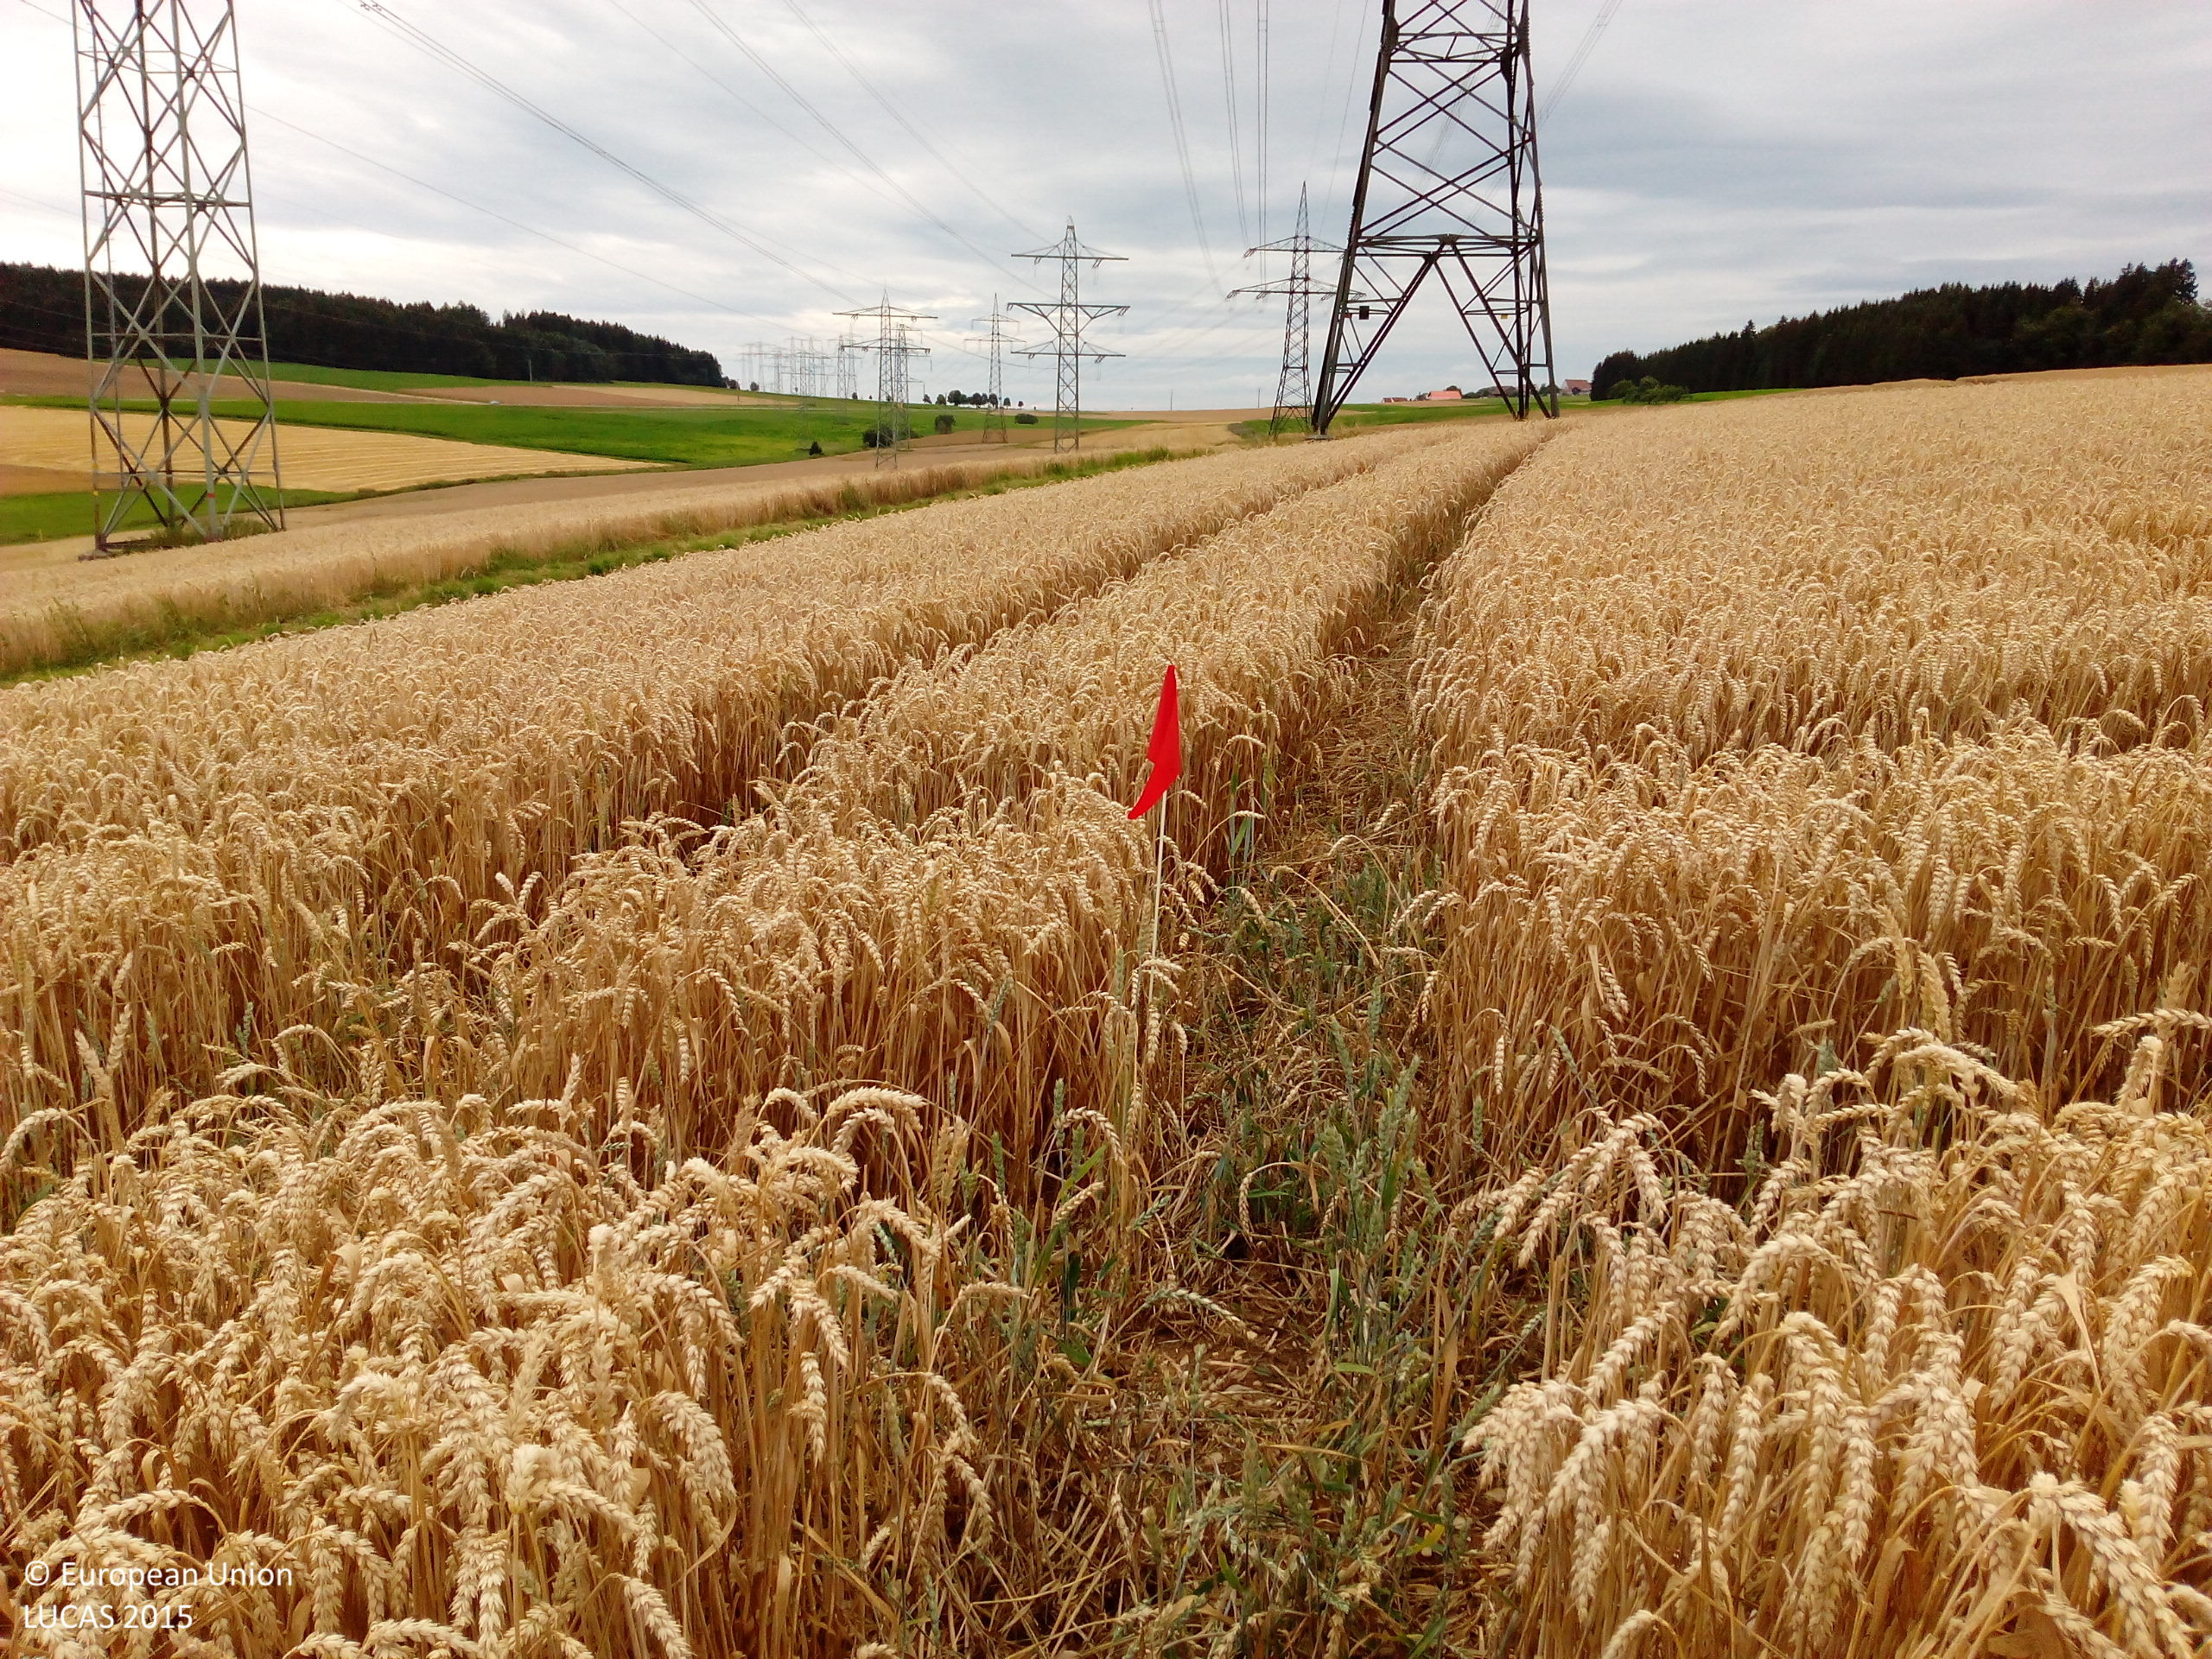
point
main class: Artificial land
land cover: Other artificial areas
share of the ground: 25 - 50 %
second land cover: Common wheat
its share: > 75 %
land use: Electricity, gas and thermal power distribution
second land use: Agriculture (excluding fallow land and kitchen gardens)
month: July
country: DE
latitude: 47.8186
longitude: 8.5986
